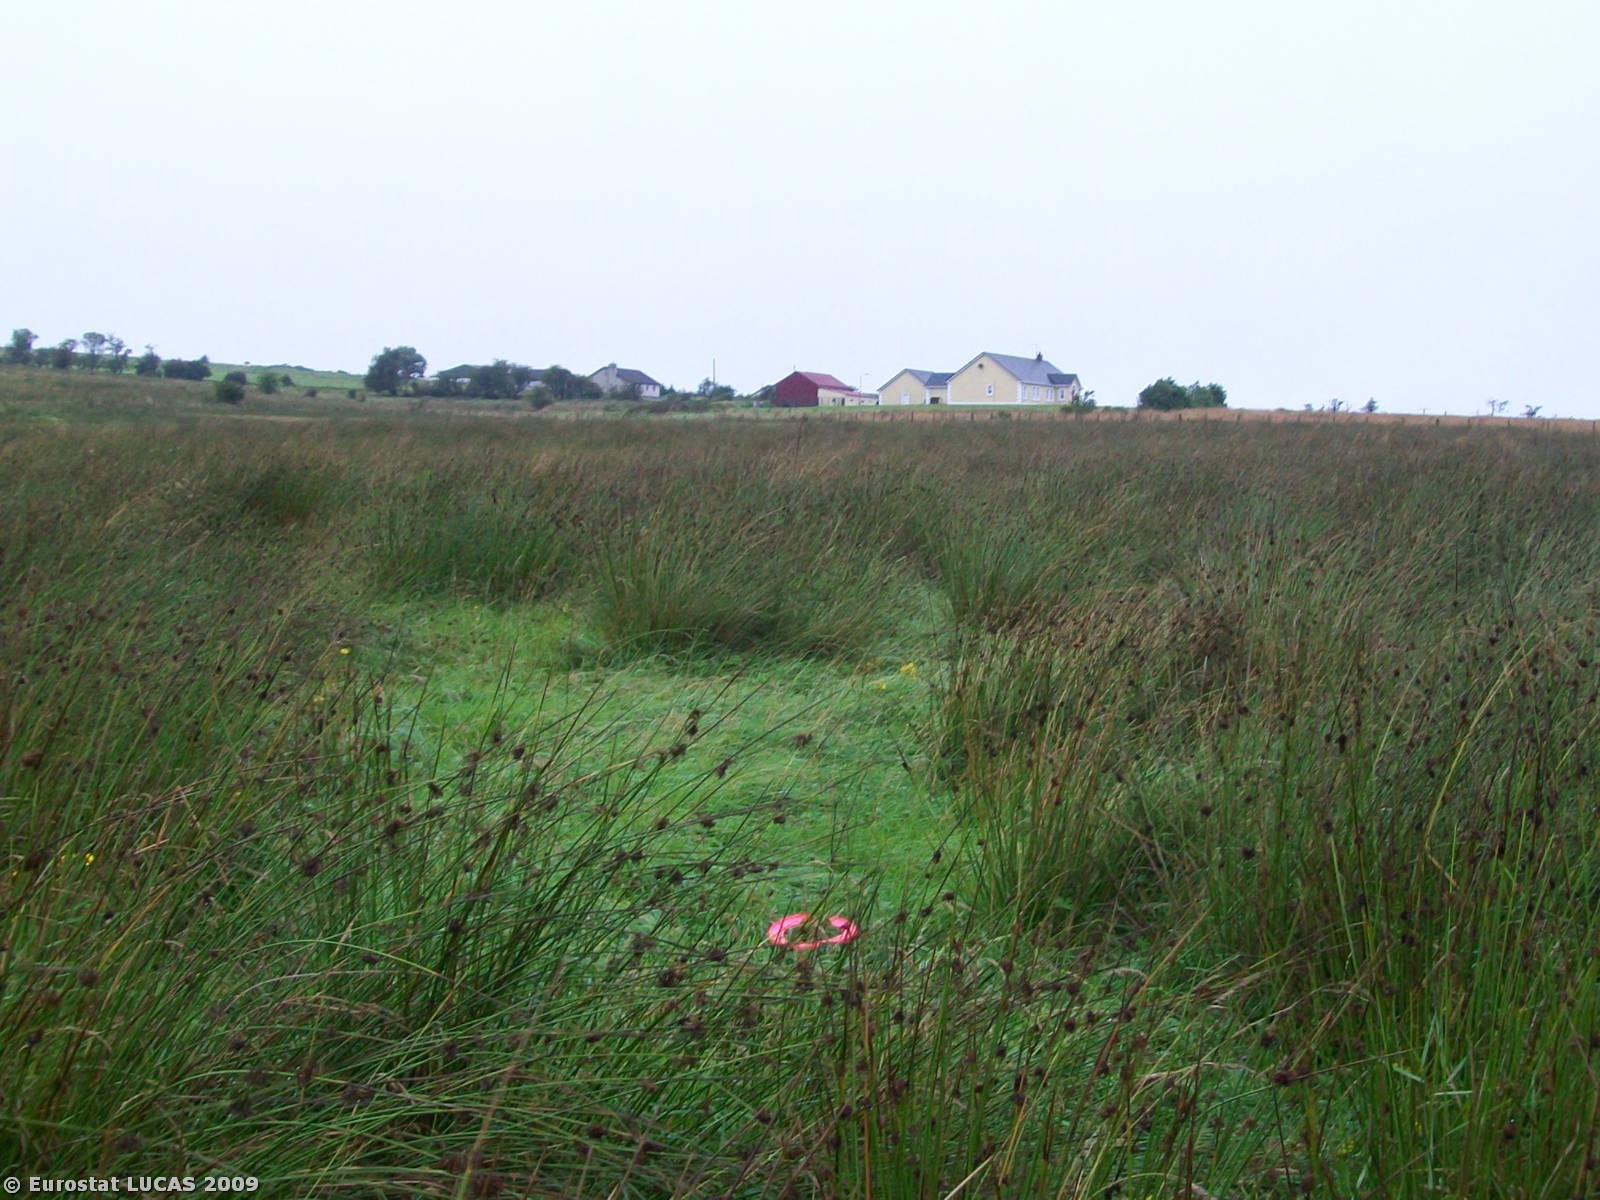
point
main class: Grassland
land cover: Grassland without tree/shrub cover
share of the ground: > 75 %
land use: Agriculture (excluding fallow land and kitchen gardens)
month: August
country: GB
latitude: 54.5780
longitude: -6.0619
